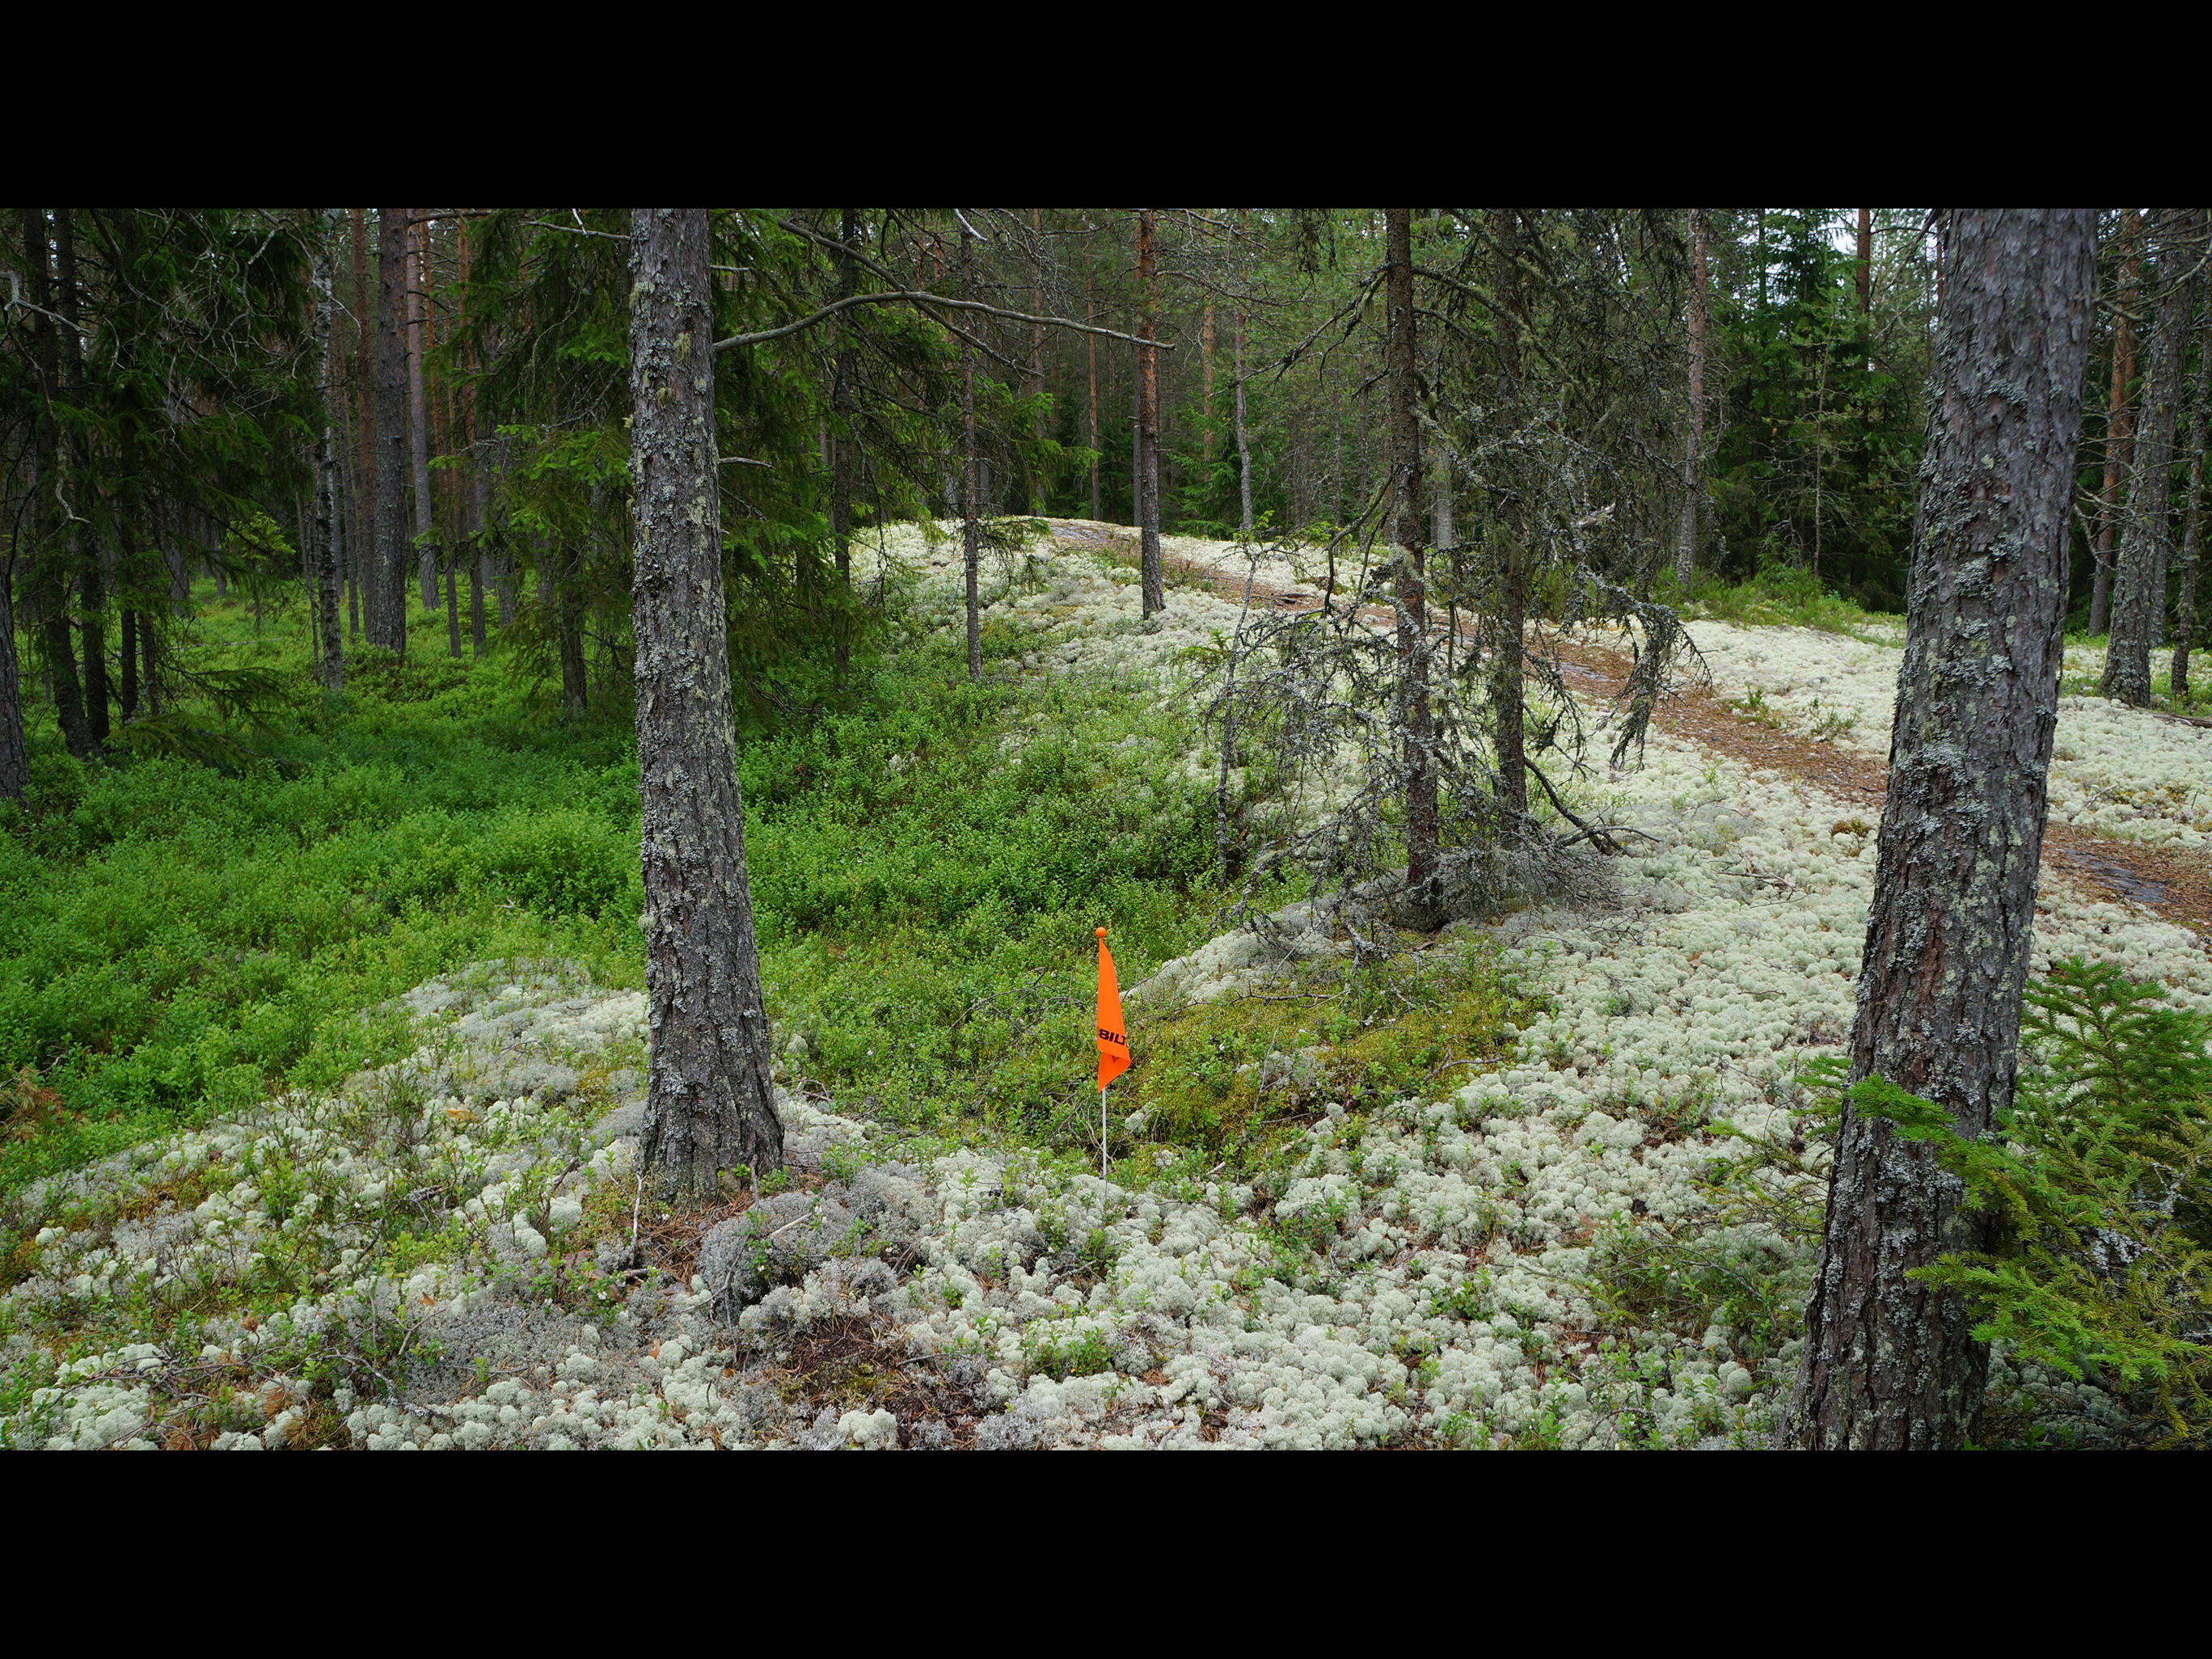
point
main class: Woodland
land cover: Pine dominated coniferous woodland
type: boreal forest
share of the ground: 50 - 75 %
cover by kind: coniferous forest trees 60 %, shrubs 20 %, lichens and mosses 15 %, broadleaved forest trees 5 %
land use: Forestry
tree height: > 5 m
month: July
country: FI
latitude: 64.0168
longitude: 23.5393
